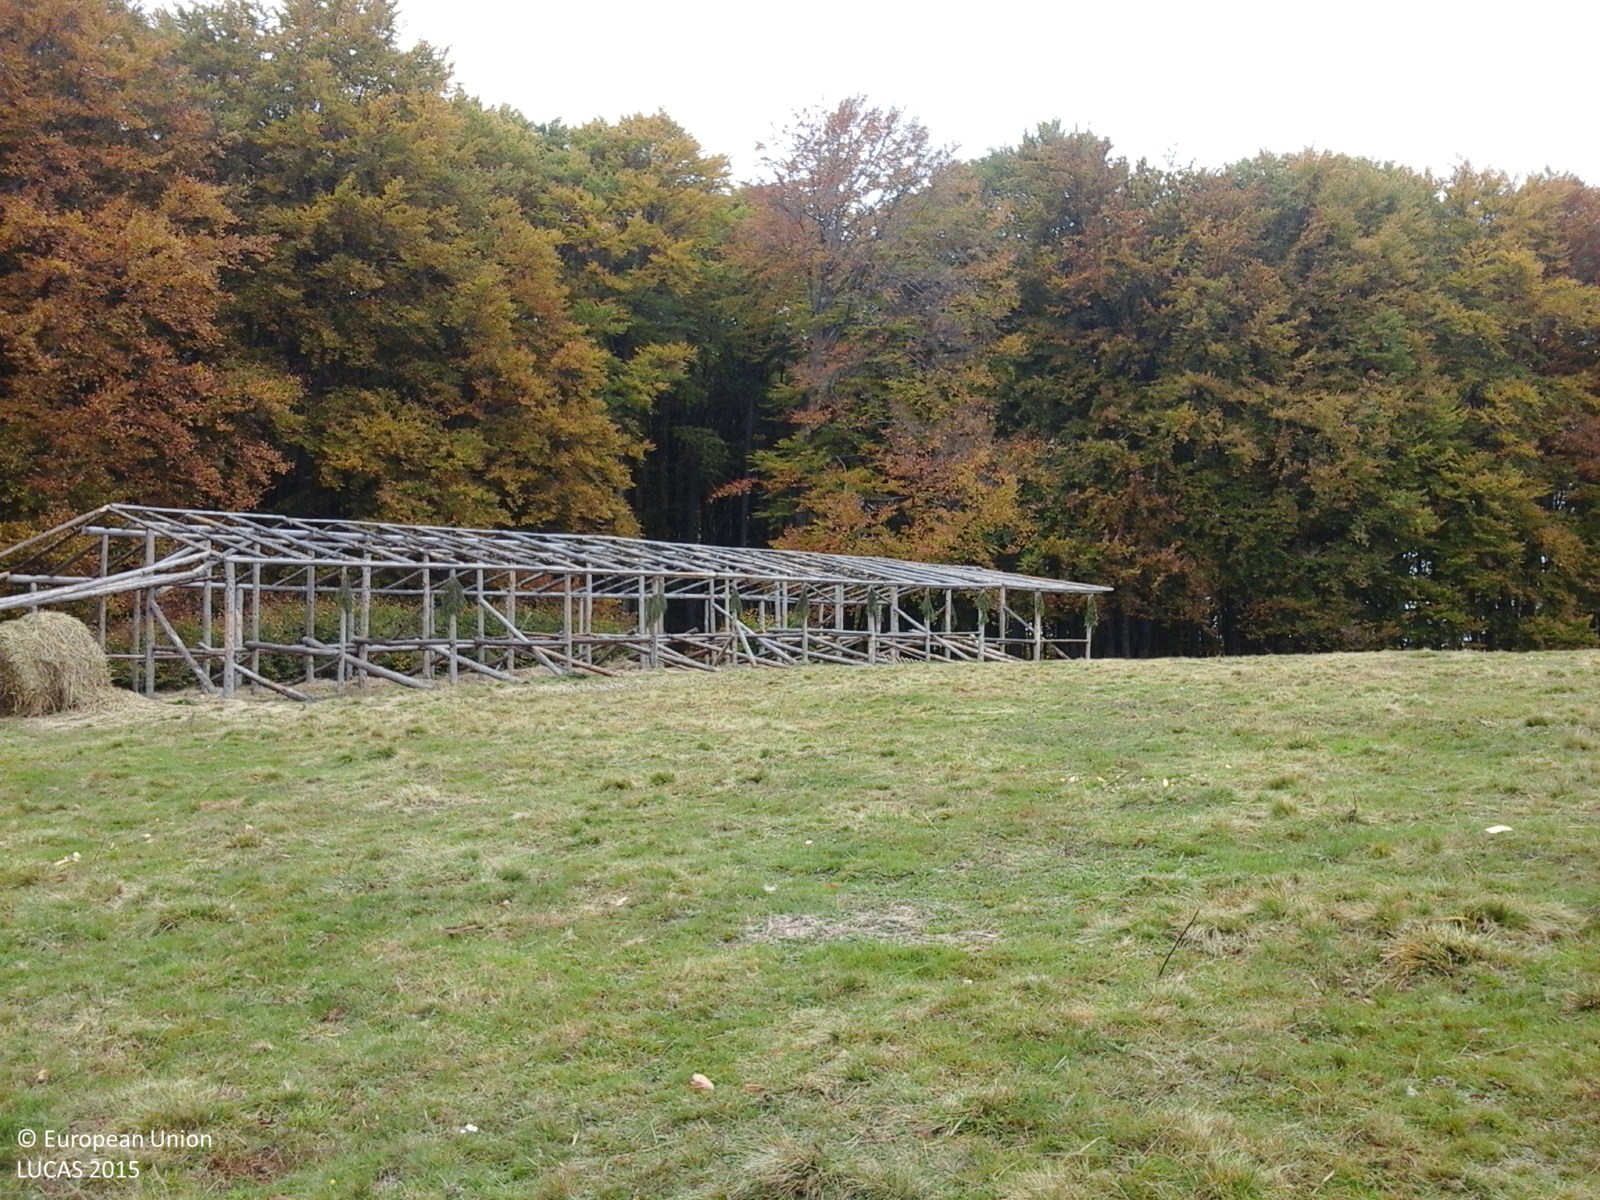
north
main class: Grassland
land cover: Grassland without tree/shrub cover
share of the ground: > 75 %
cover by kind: herbaceous plants 100 %
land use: Agriculture (excluding fallow land and kitchen gardens)
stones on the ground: < 10 %
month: October
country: RO
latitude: 46.6084
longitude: 24.9685
